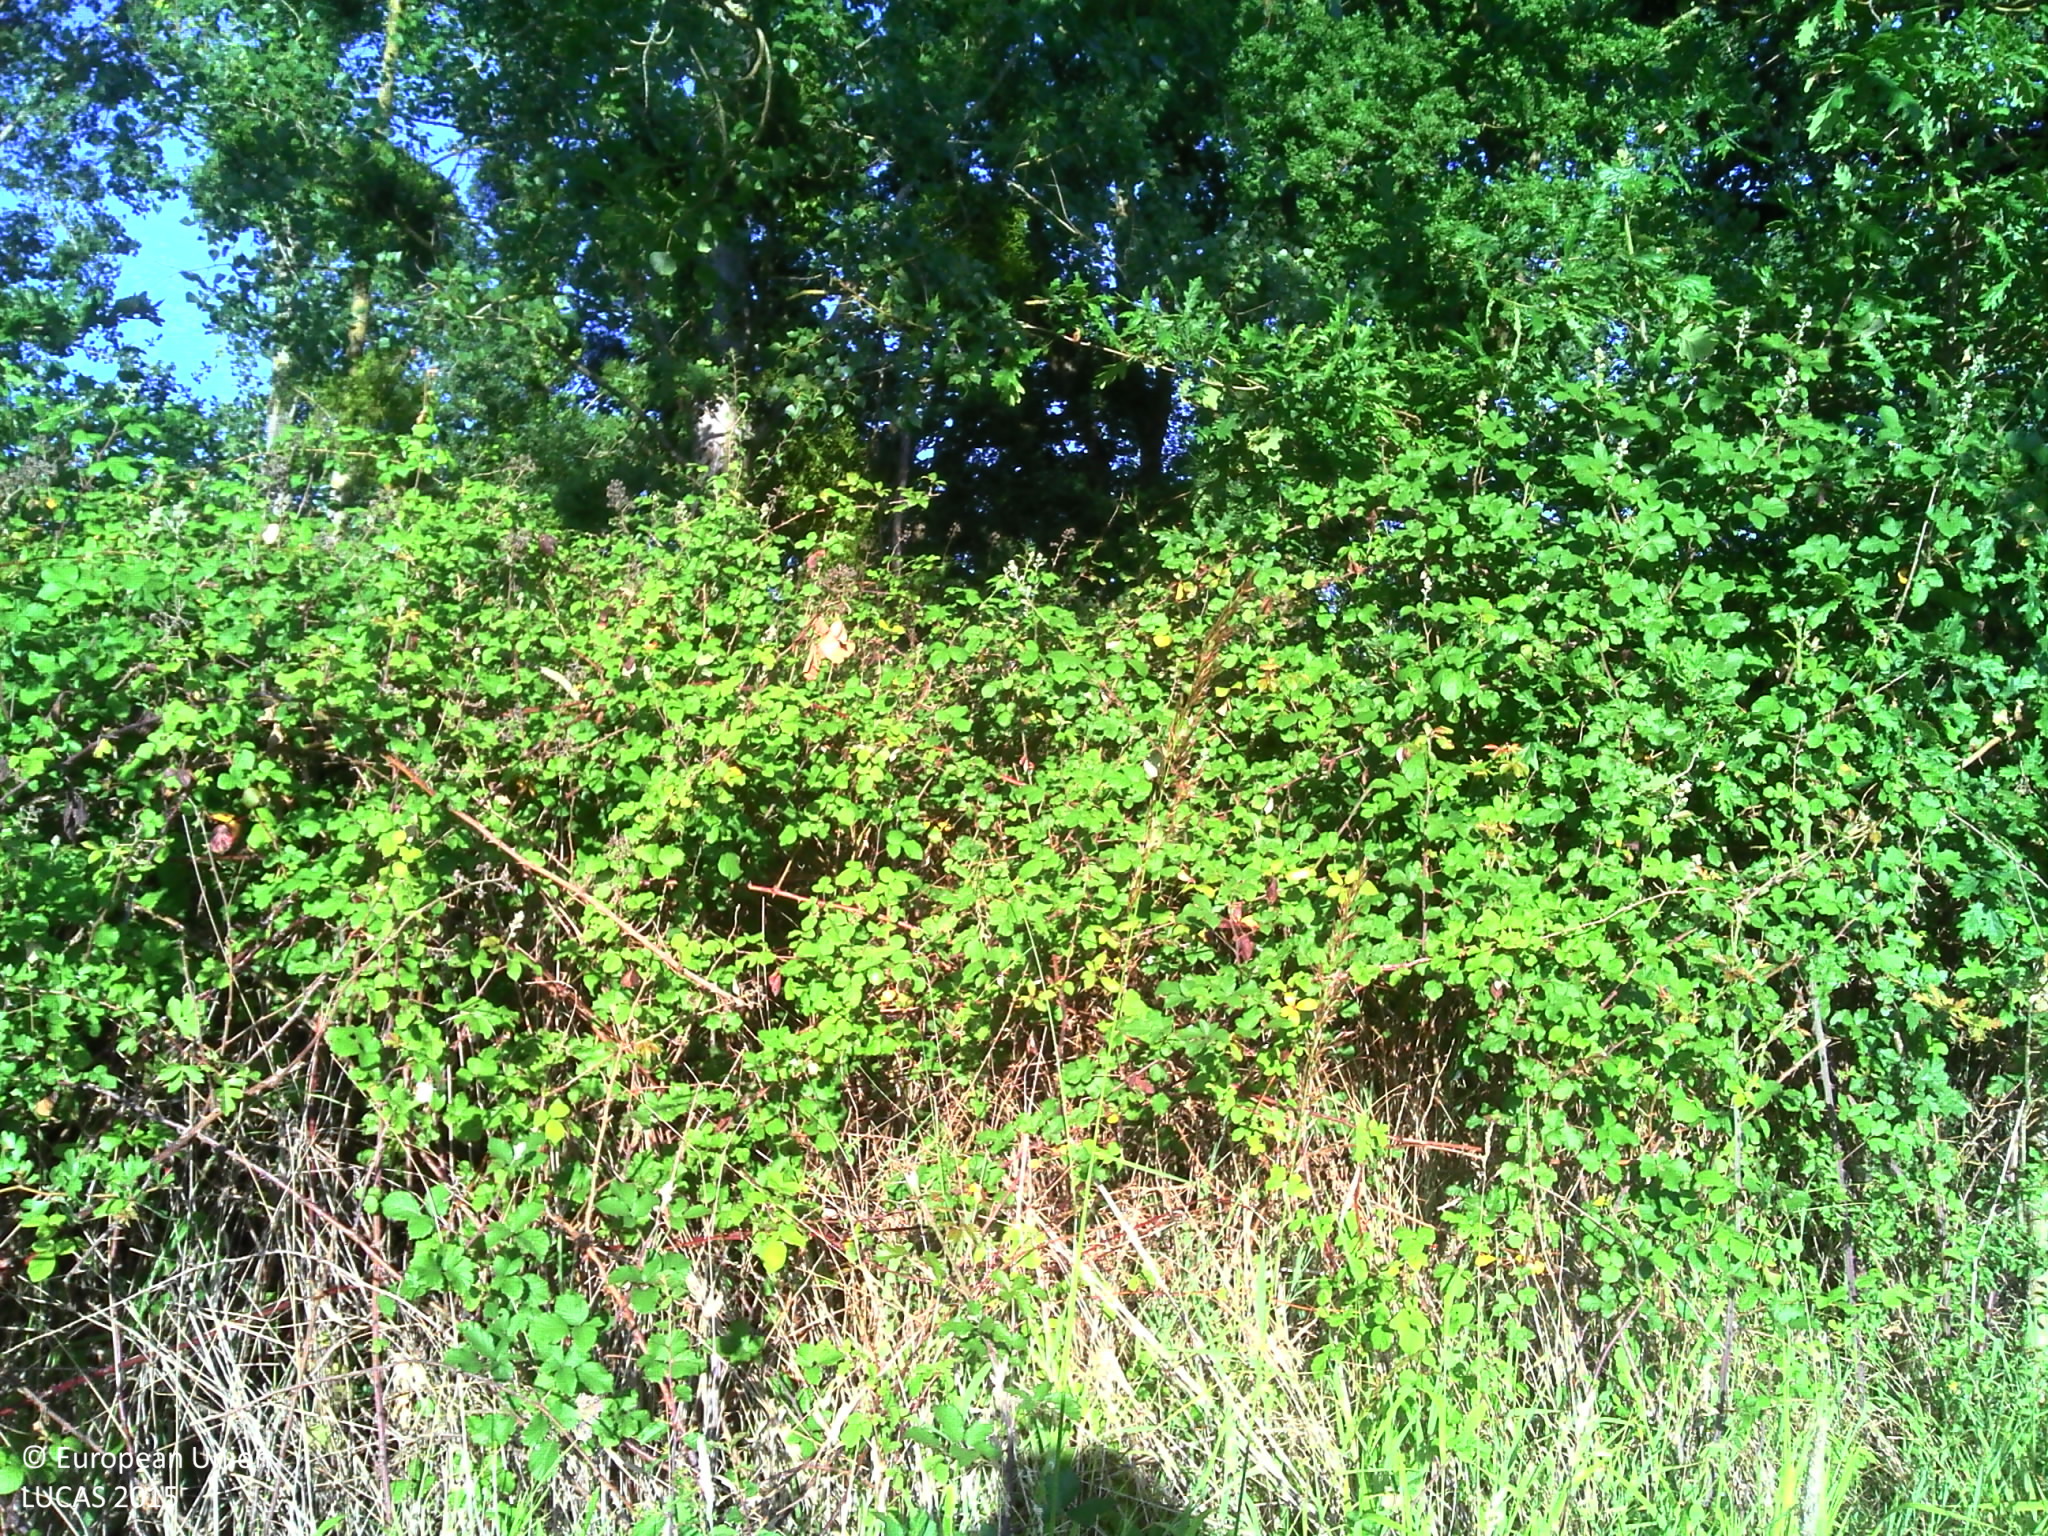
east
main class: Woodland
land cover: Broadleaved woodland
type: exotic forest
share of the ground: > 75 %
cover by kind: broadleaved forest trees 70 %, herbaceous plants 30 %
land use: Forestry
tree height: > 5 m
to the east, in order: Broadleaved woodland; Grassland without tree/shrub cover; Broadleaved woodland; Grassland without tree/shrub cover; Broadleaved woodland; Grassland without tree/shrub cover; Broadleaved woodland; Grassland without tree/shrub cover
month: June
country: FR
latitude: 47.4346
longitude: 0.1242
